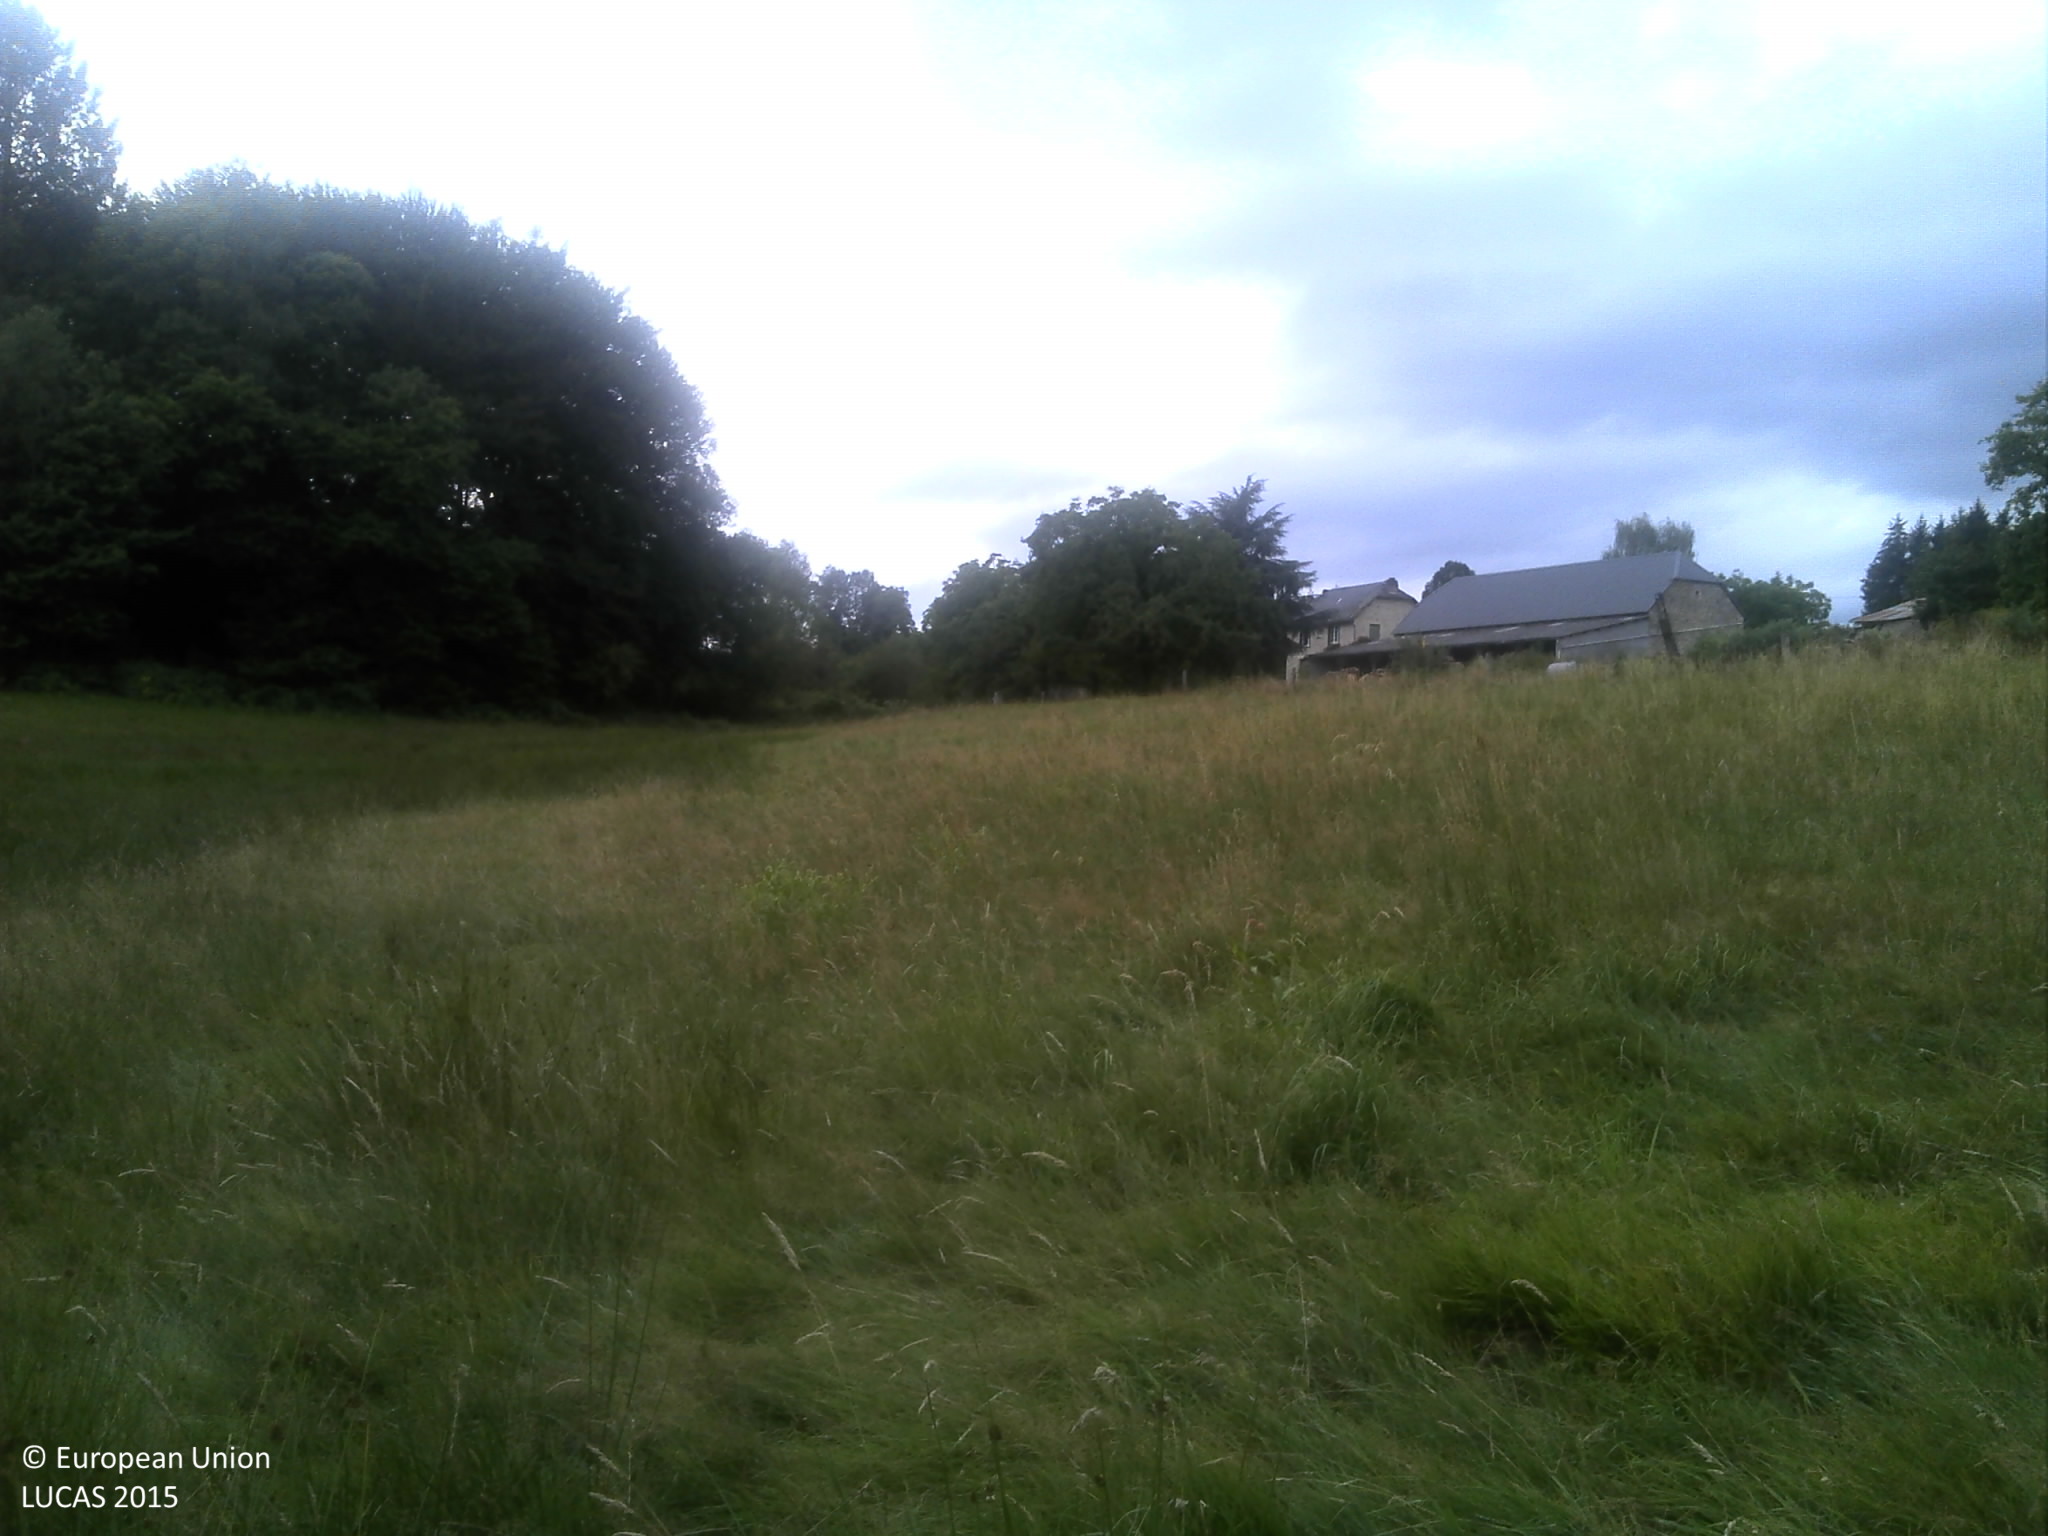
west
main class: Grassland
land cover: Grassland without tree/shrub cover
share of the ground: > 75 %
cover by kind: herbaceous plants 100 %
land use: Agriculture (excluding fallow land and kitchen gardens)
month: July
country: FR
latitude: 45.2118
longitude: 1.9117
